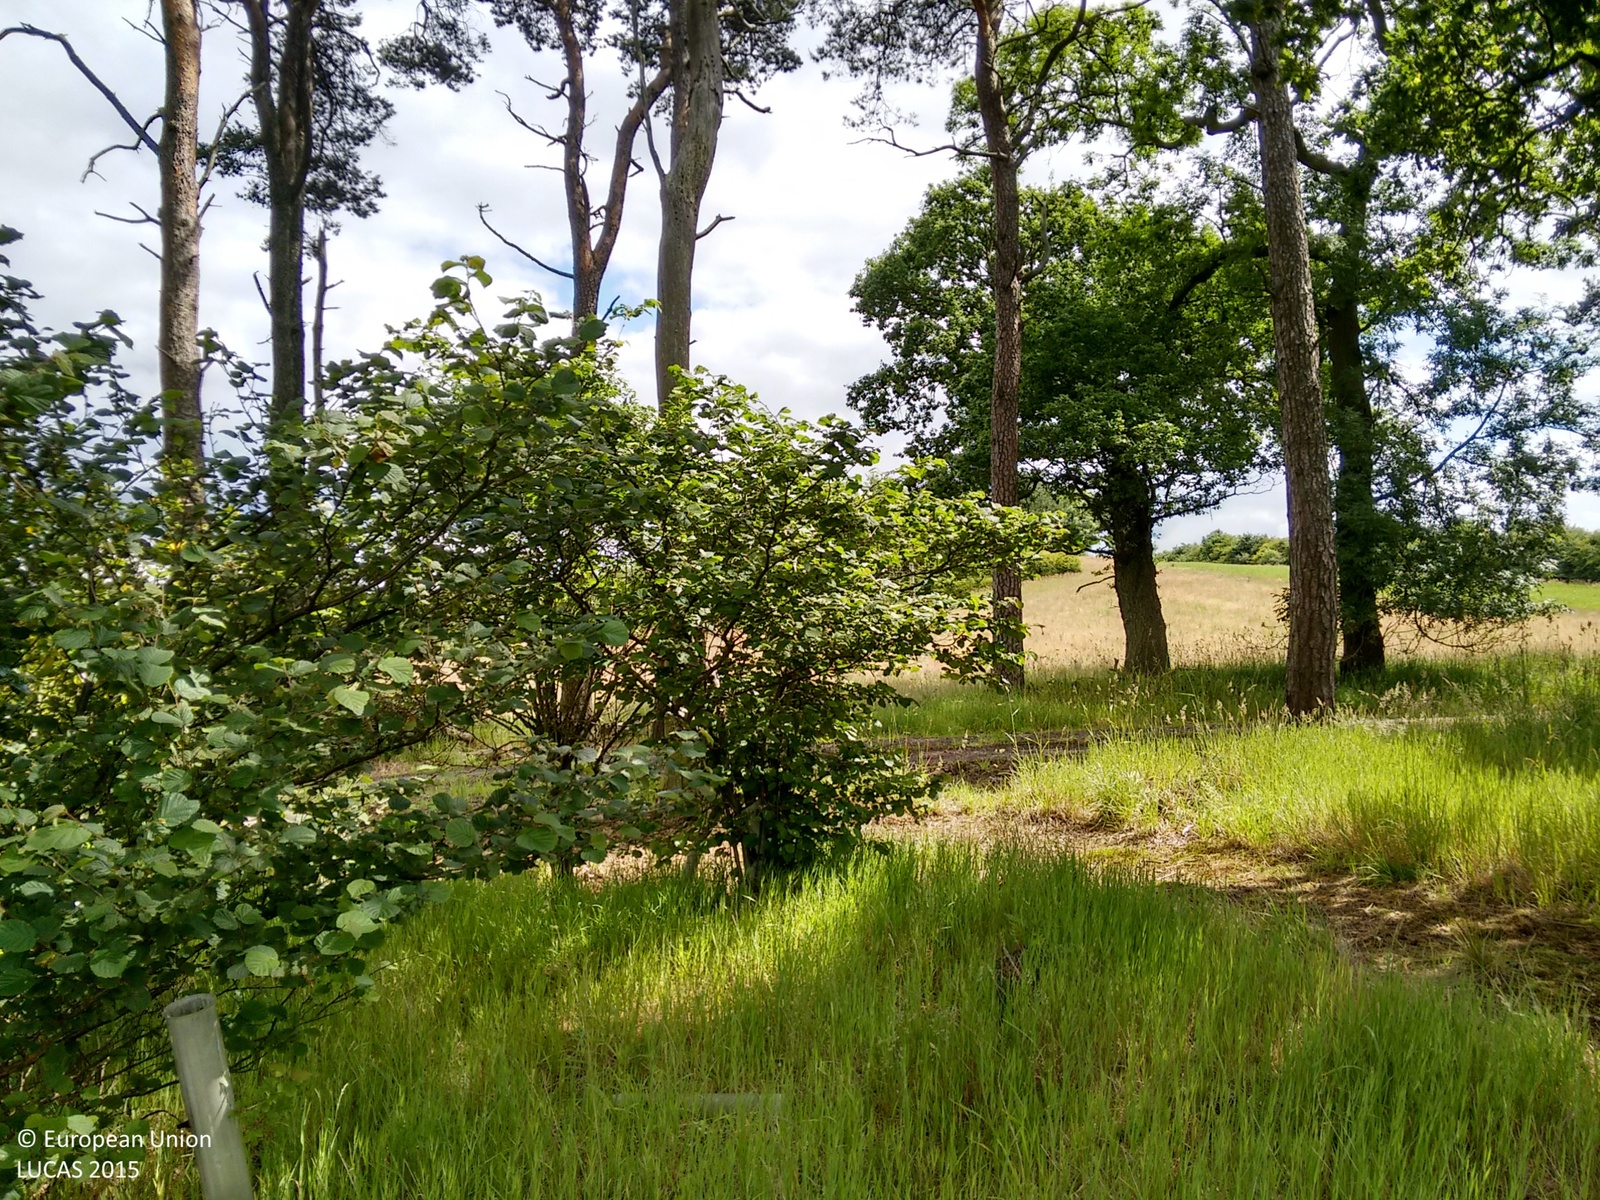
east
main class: Woodland
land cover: Pine dominated mixed woodland
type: exotic forest
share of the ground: > 75 %
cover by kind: coniferous forest trees 65 %, broadleaved forest trees 25 %, herbaceous plants 10 %
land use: Agriculture (excluding fallow land and kitchen gardens)
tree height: > 5 m
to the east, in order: Dry stone walls; Pine dominated mixed woodland; Tracks; Lines of trees; Grassland without tree/shrub cover; Electric lines; Grassland without tree/shrub cover; Broadleaved woodland; Other mixed woodland
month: July
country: GB
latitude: 56.1060
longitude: -3.6994
